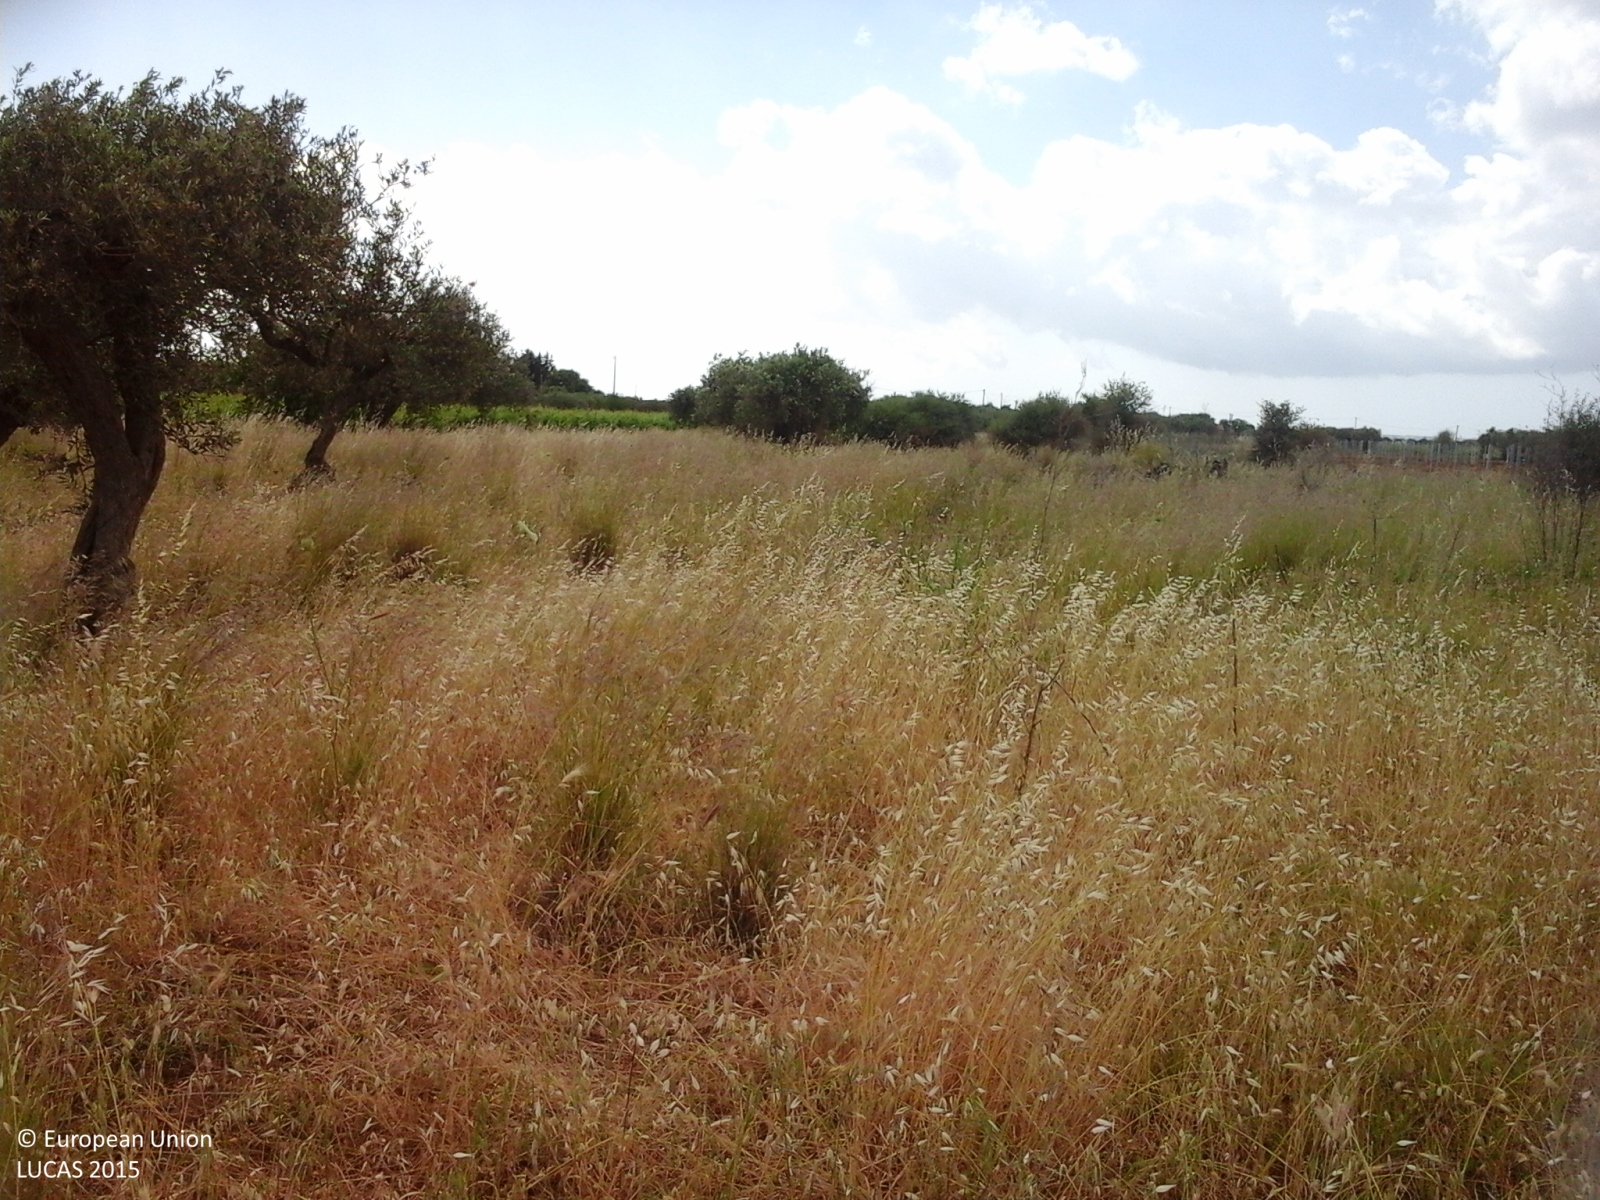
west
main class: Grassland
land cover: Spontaneously vegetated surfaces
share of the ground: > 75 %
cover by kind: herbaceous plants 90 %, consolidated bare surface 10 %
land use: Agriculture (excluding fallow land and kitchen gardens)
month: May
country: IT
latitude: 37.6121
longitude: 12.9119
